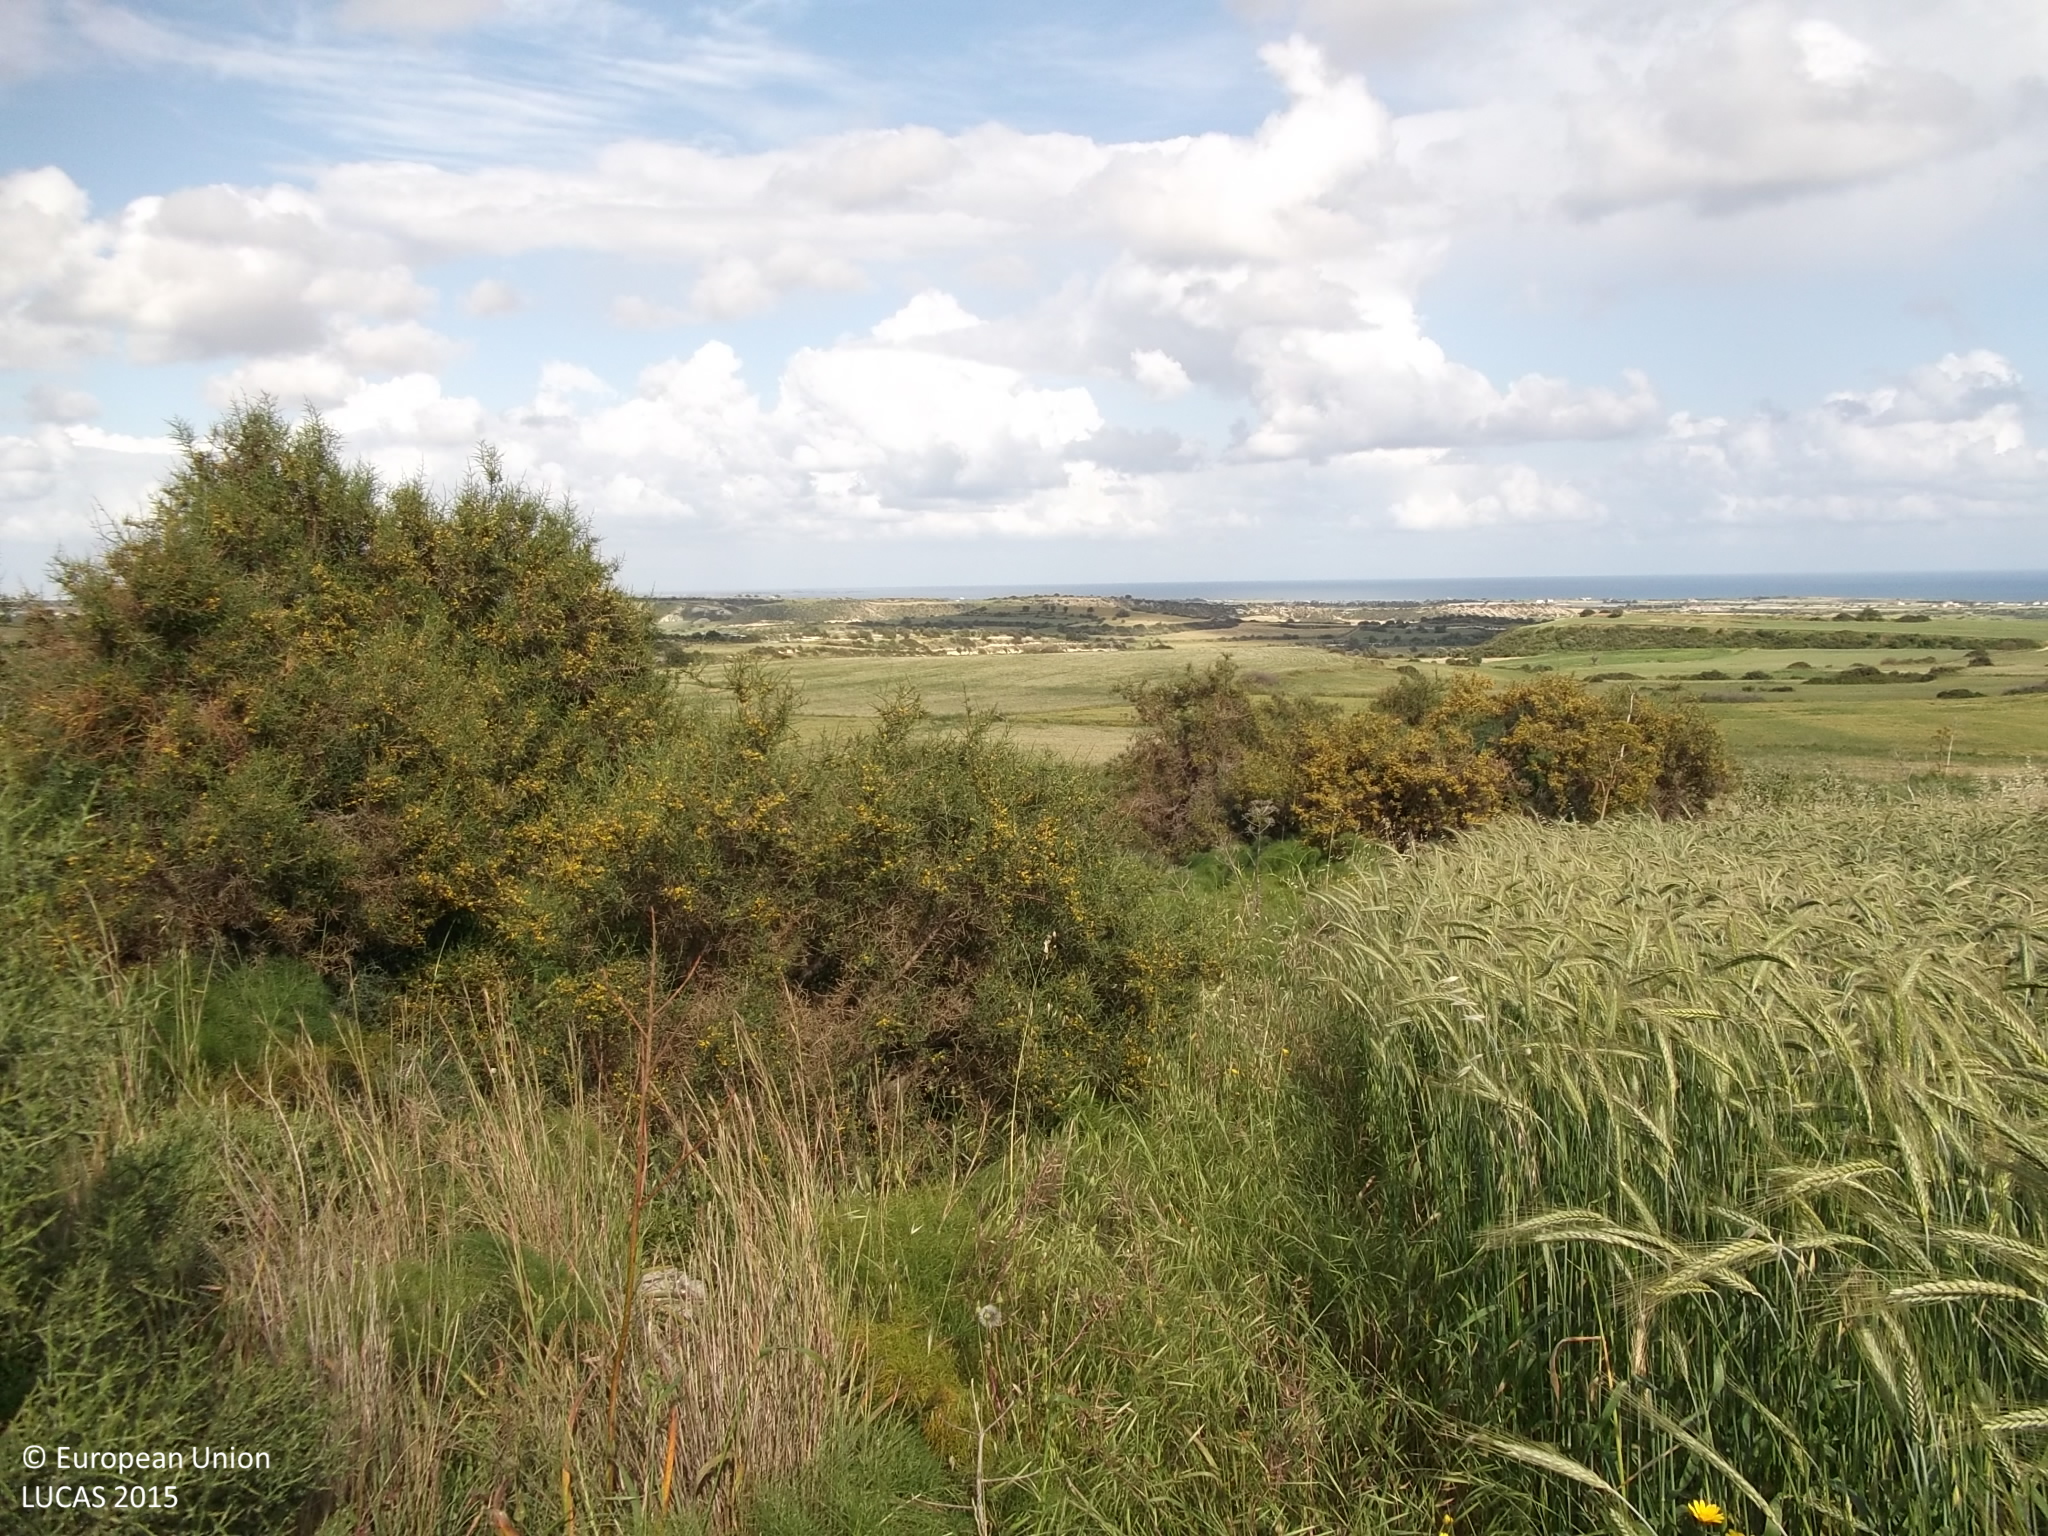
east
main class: Shrubland
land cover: Shrubland without tree cover
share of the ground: 50 - 75 %
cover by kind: shrubs 70 %, herbaceous plants 20 %, unconsolidated bare surface 10 %
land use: Semi-natural and natural areas not in use
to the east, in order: Shrubland without tree cover; Barley; Shrubland without tree cover; Mixed cereals for fodder; Grass margins; Mixed cereals for fodder; Grassland without tree/shrub cover; Tracks
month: April
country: CY
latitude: 34.7952
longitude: 33.4313
